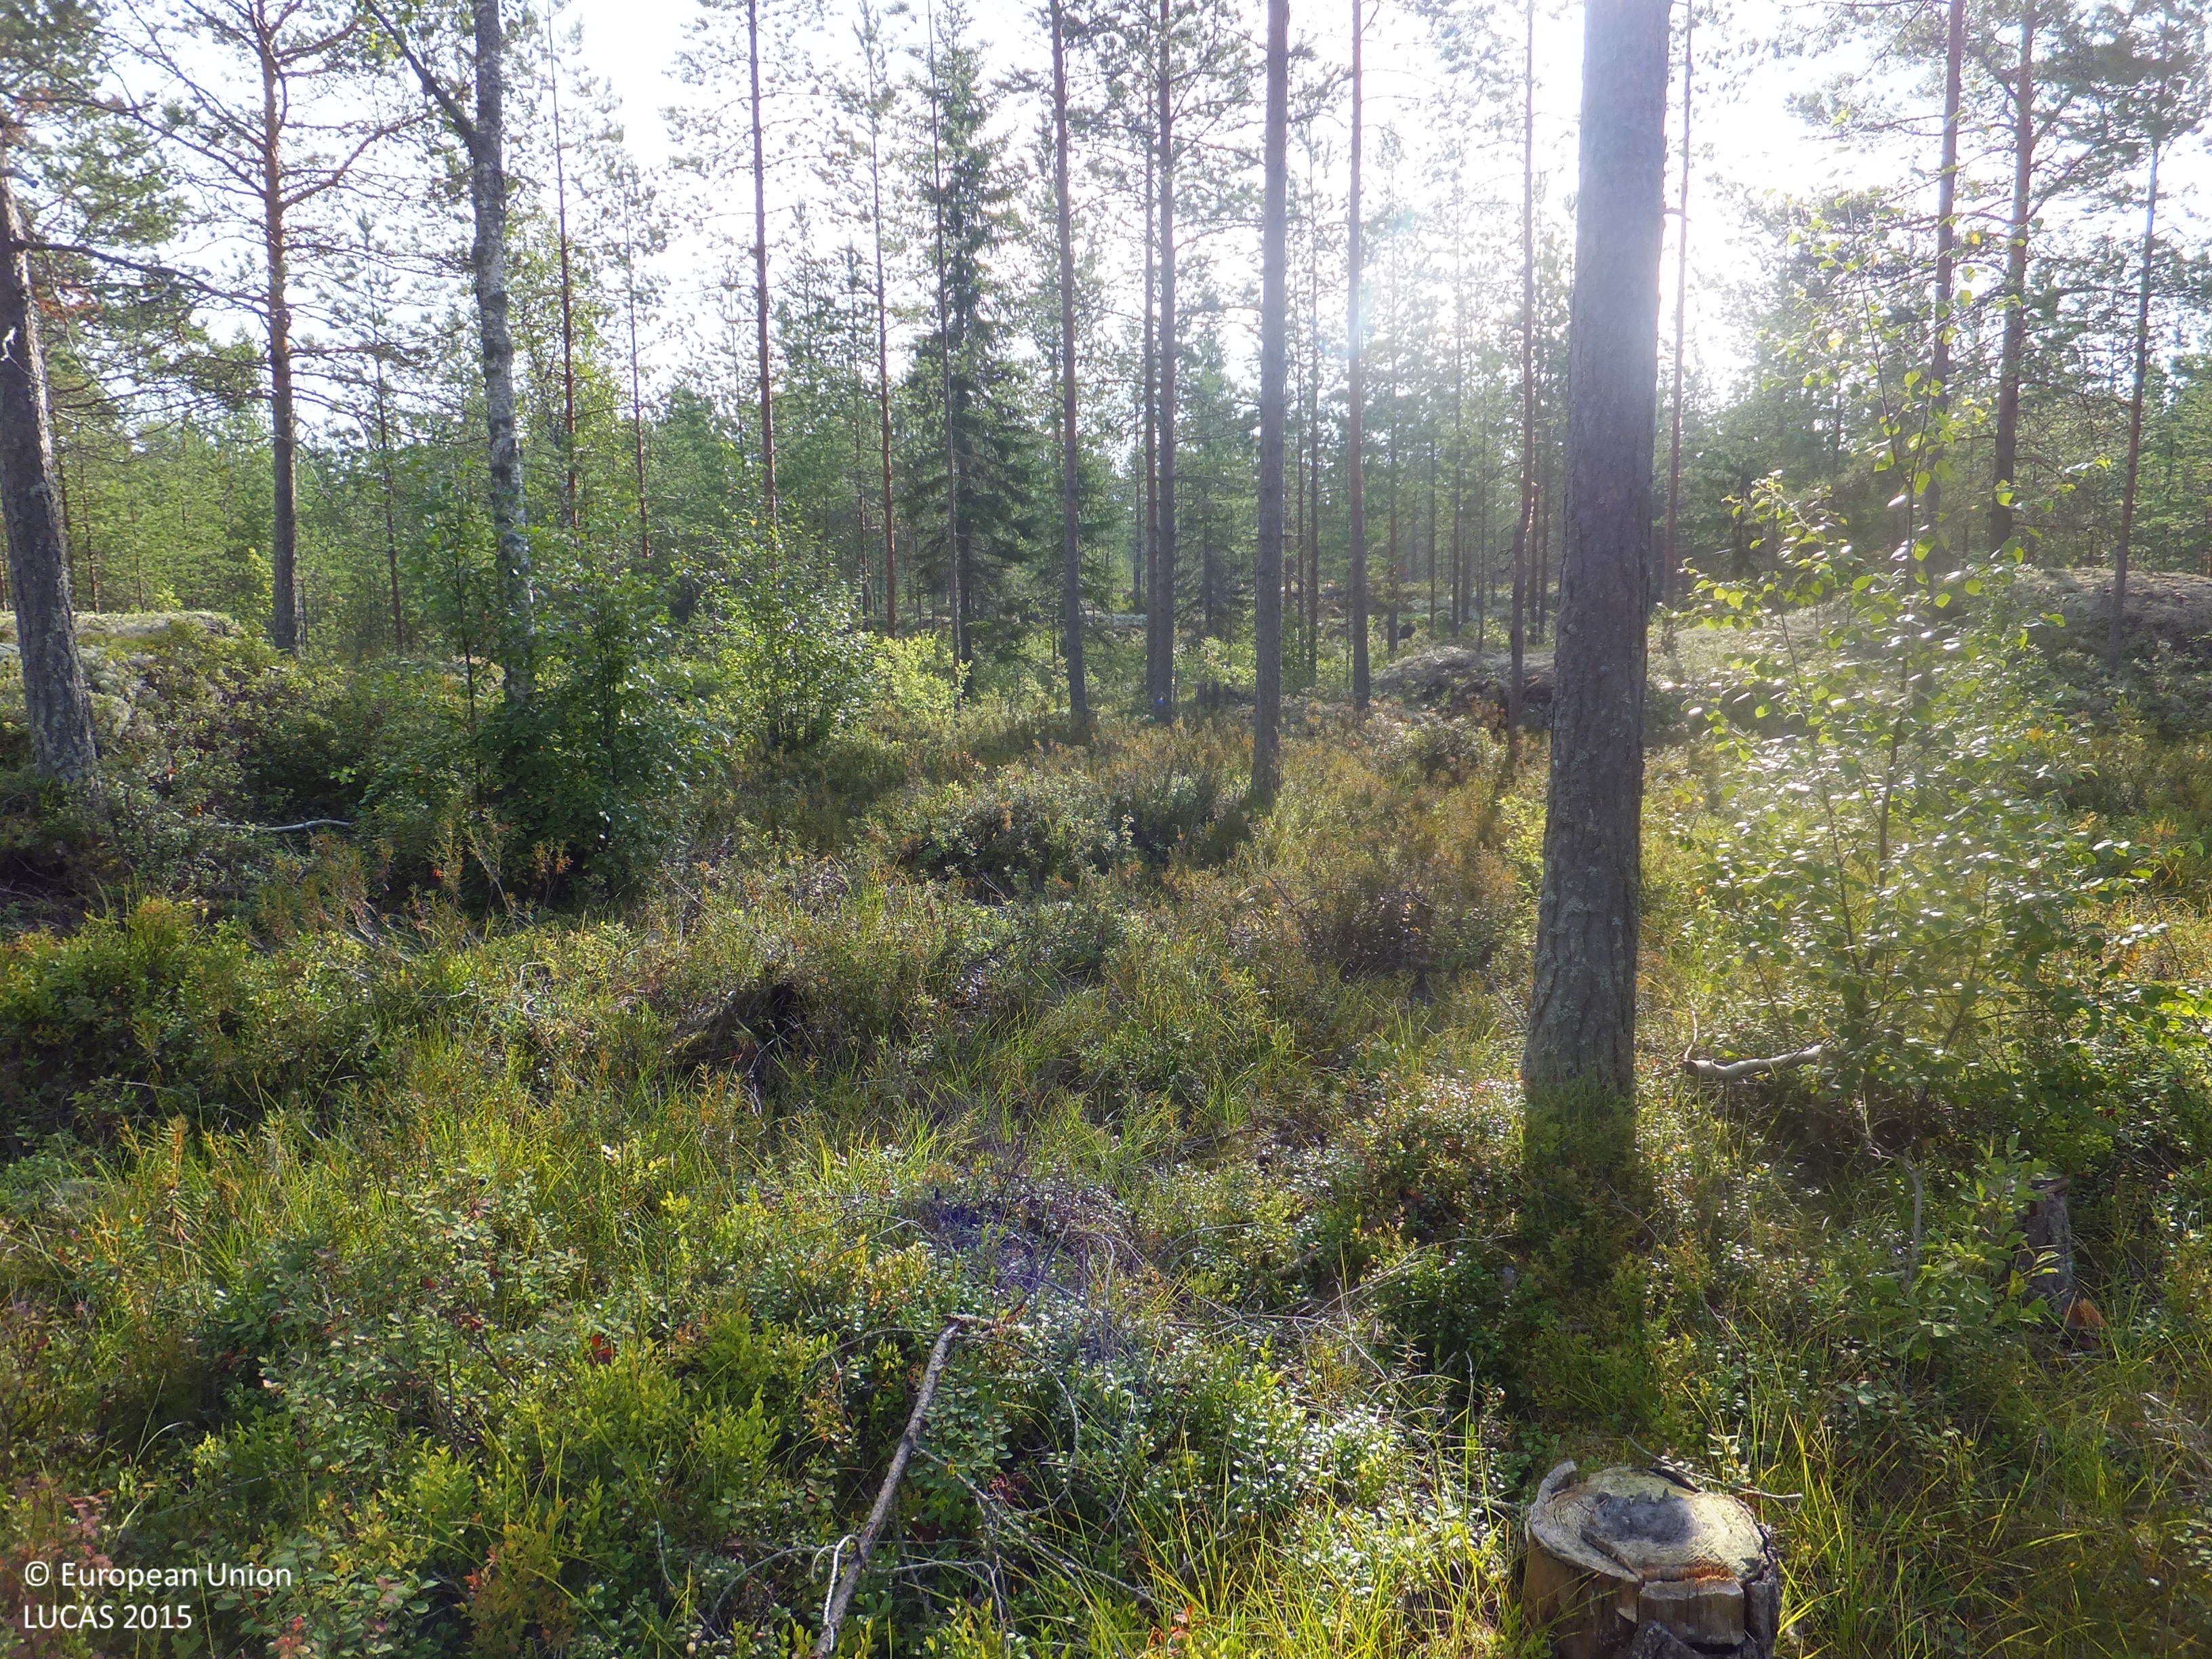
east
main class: Woodland
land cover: Pine dominated coniferous woodland
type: boreal forest
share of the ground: 25 - 50 %
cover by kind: coniferous forest trees 35 %, shrubs 30 %, lichens and mosses 15 %, herbaceous plants 10 %, broadleaved forest trees 5 %, consolidated bare surface 5 %
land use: Forestry
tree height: > 5 m
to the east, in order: Pine dominated coniferous woodland
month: August
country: FI
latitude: 63.1442
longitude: 23.0142
